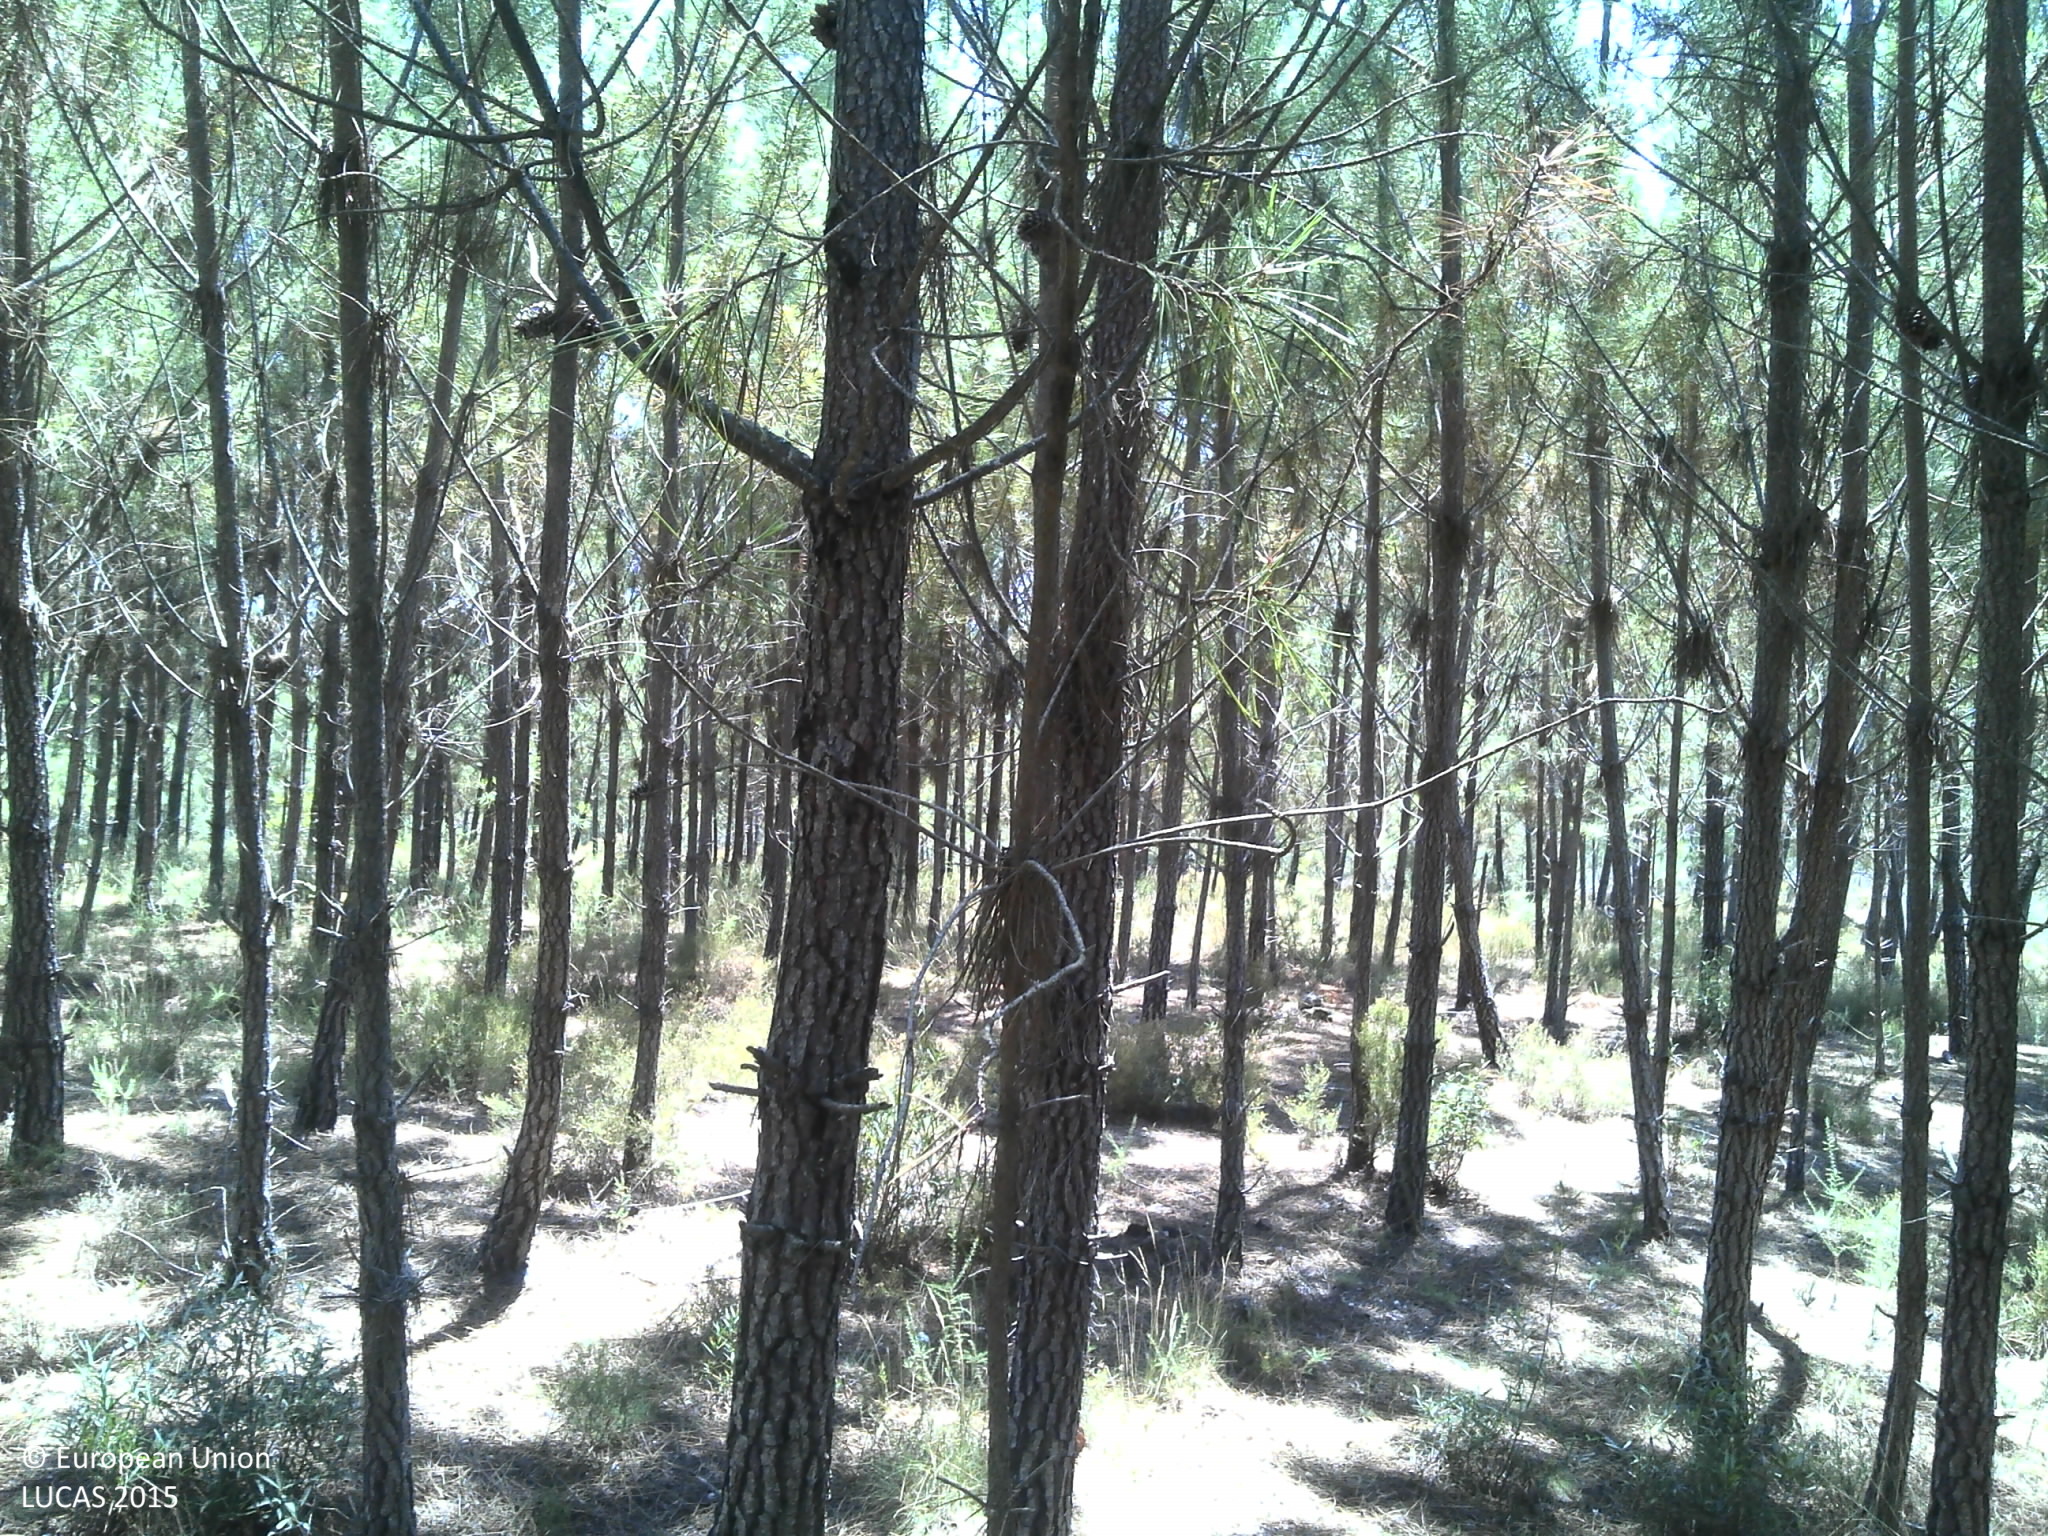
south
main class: Woodland
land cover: Pine dominated coniferous woodland
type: coniferous forest of the mediterranean region
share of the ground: 50 - 75 %
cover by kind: coniferous forest trees 75 %, unconsolidated bare surface 15 %, shrubs 10 %
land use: Forestry
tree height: > 5 m
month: June
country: PT
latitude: 40.5080
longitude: -8.0030
